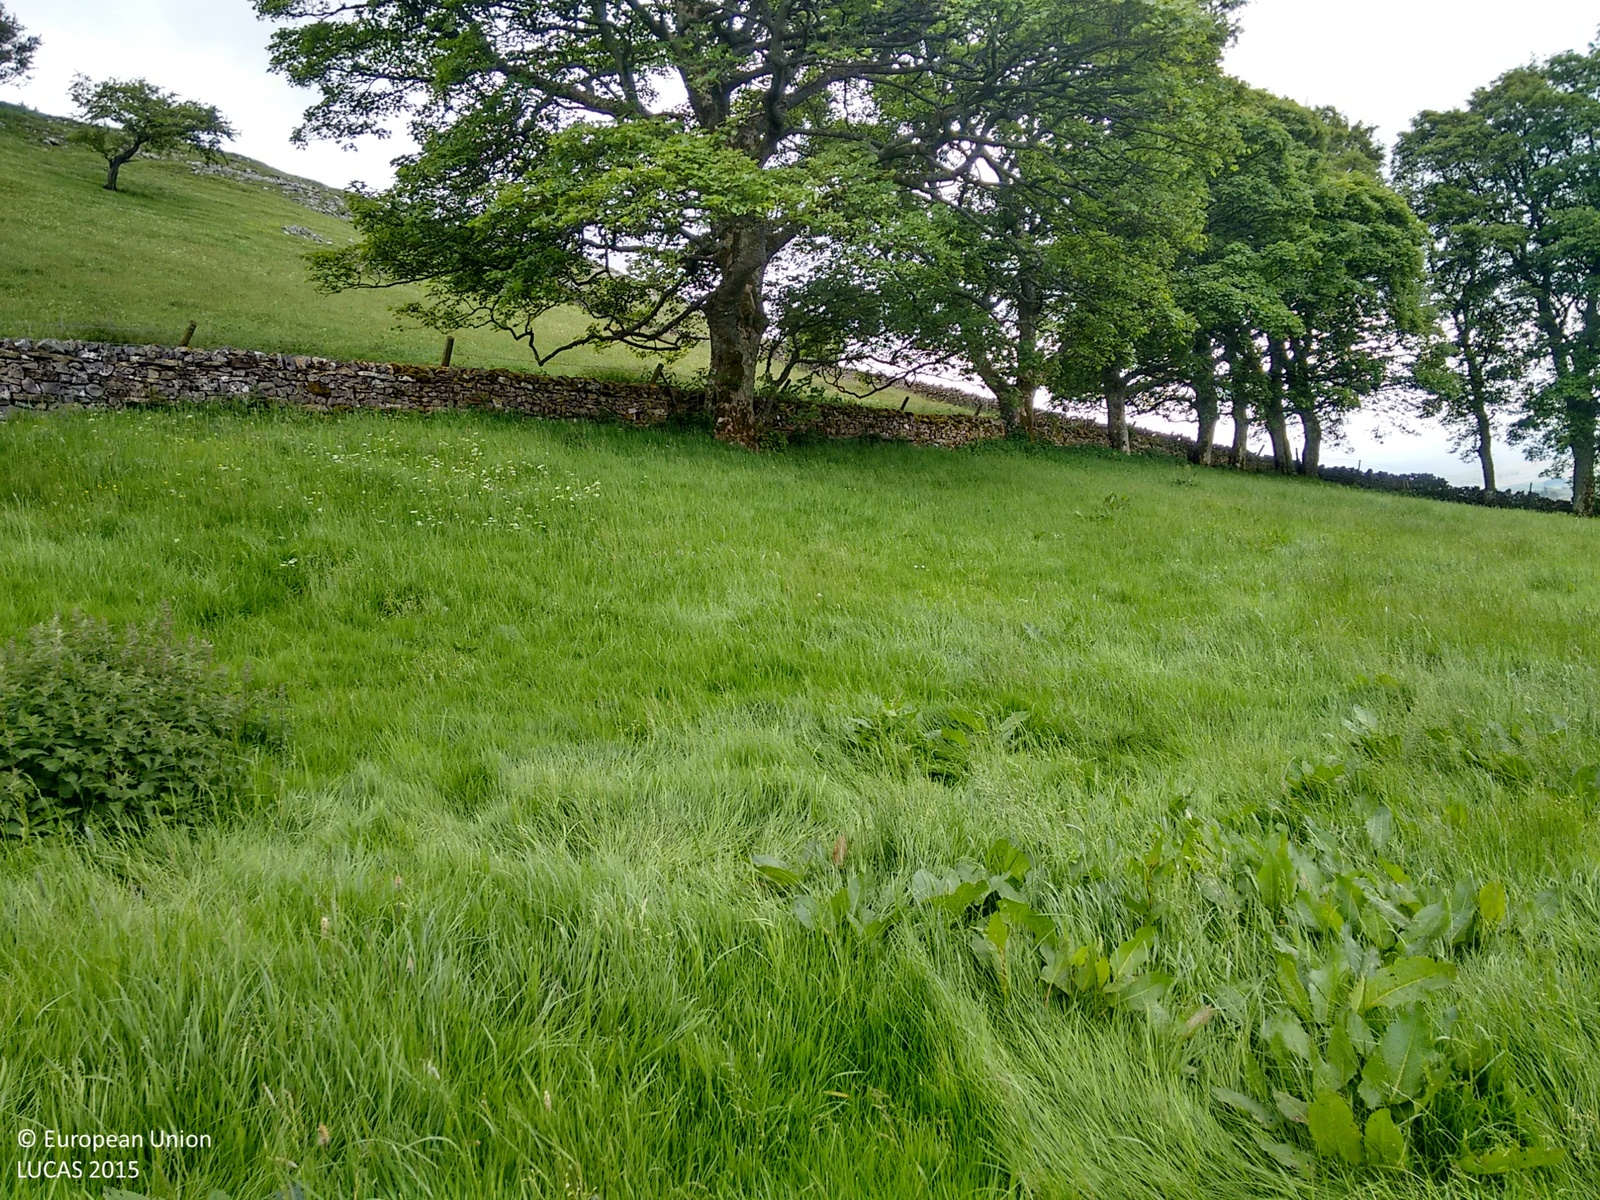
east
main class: Grassland
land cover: Grassland without tree/shrub cover
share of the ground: > 75 %
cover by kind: herbaceous plants 100 %
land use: Agriculture (excluding fallow land and kitchen gardens)
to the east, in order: Grassland without tree/shrub cover; Single bushes/trees; Dry stone walls; Fences; Grassland without tree/shrub cover; Dry stone walls; Grassland without tree/shrub cover; Dry stone walls; Grassland without tree/shrub cover
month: June
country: GB
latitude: 54.8183
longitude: -2.4026
